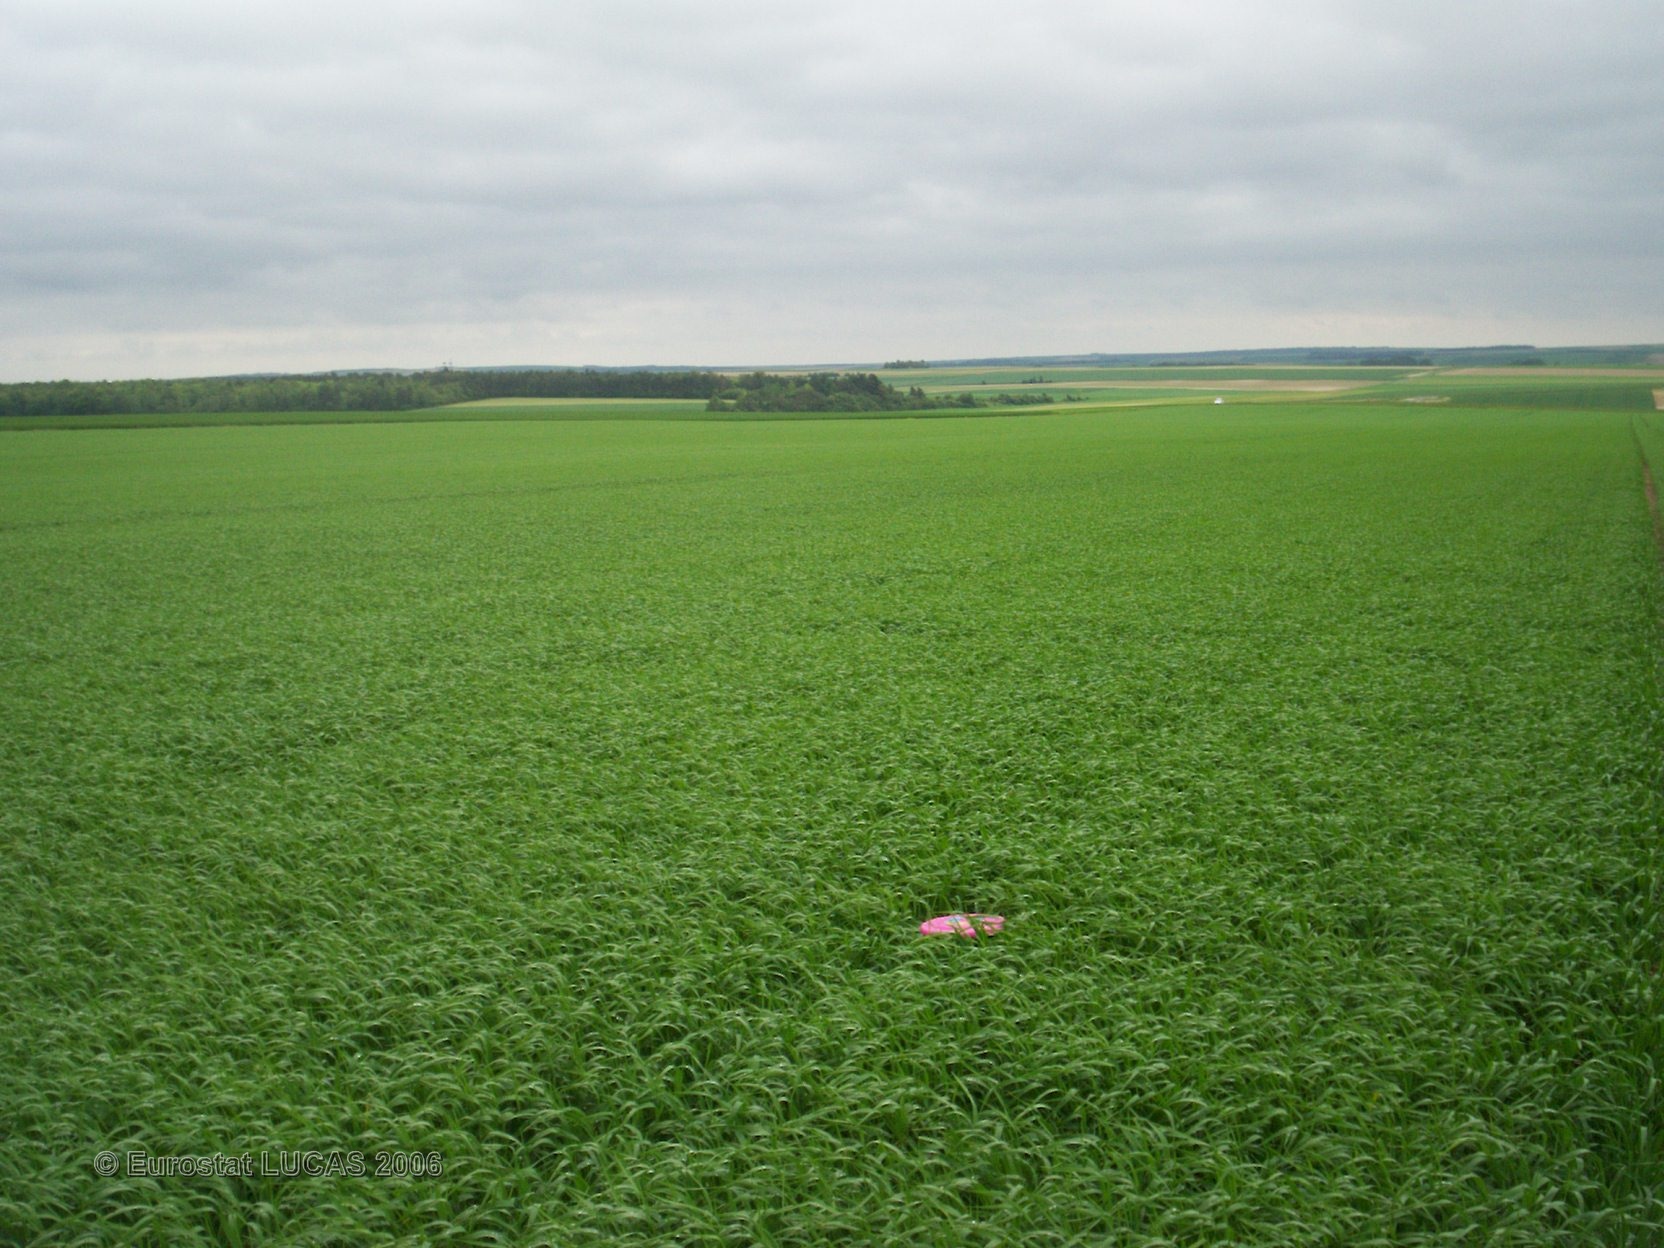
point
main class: Cropland
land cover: Barley
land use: Agriculture (excluding fallow land and kitchen gardens)
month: May
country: FR
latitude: 49.3267
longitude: 4.4236
